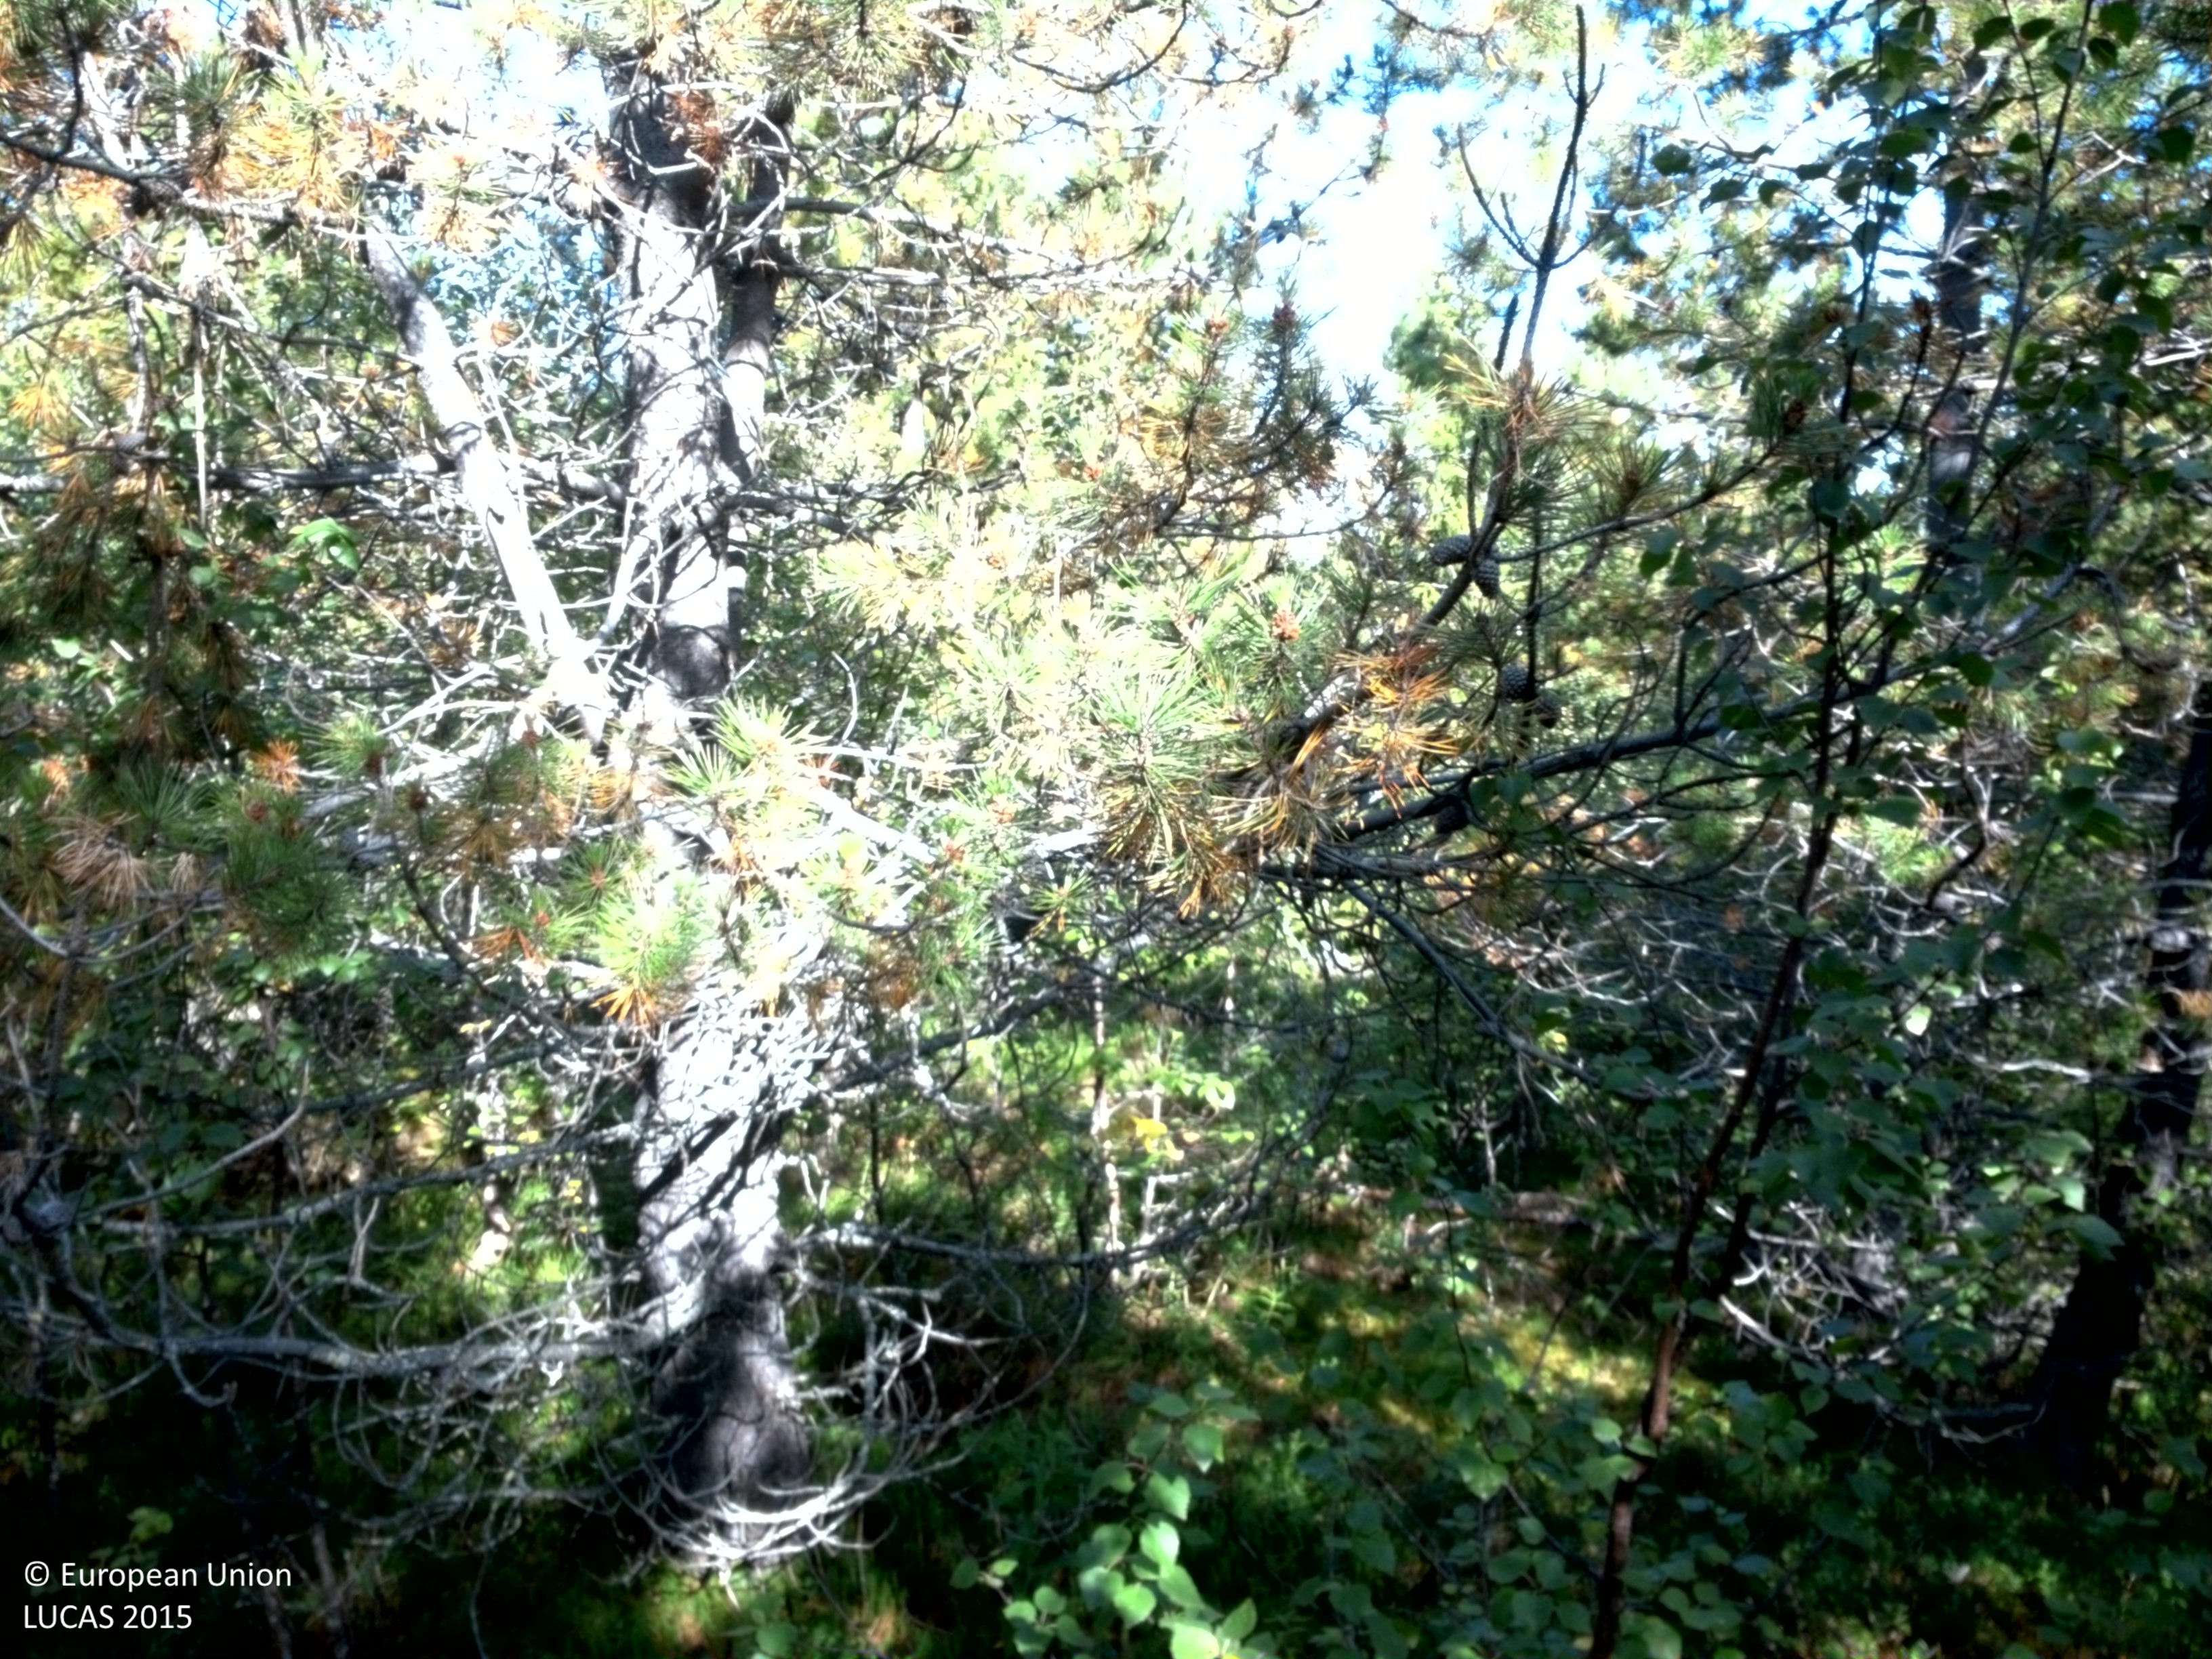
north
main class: Woodland
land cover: Pine dominated mixed woodland
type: exotic forest
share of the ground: 50 - 75 %
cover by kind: coniferous forest trees 35 %, shrubs 25 %, herbaceous plants 20 %, broadleaved forest trees 15 %, lichens and mosses 5 %
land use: Forestry
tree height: > 5 m
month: September
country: SE
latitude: 65.0614
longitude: 16.5322
